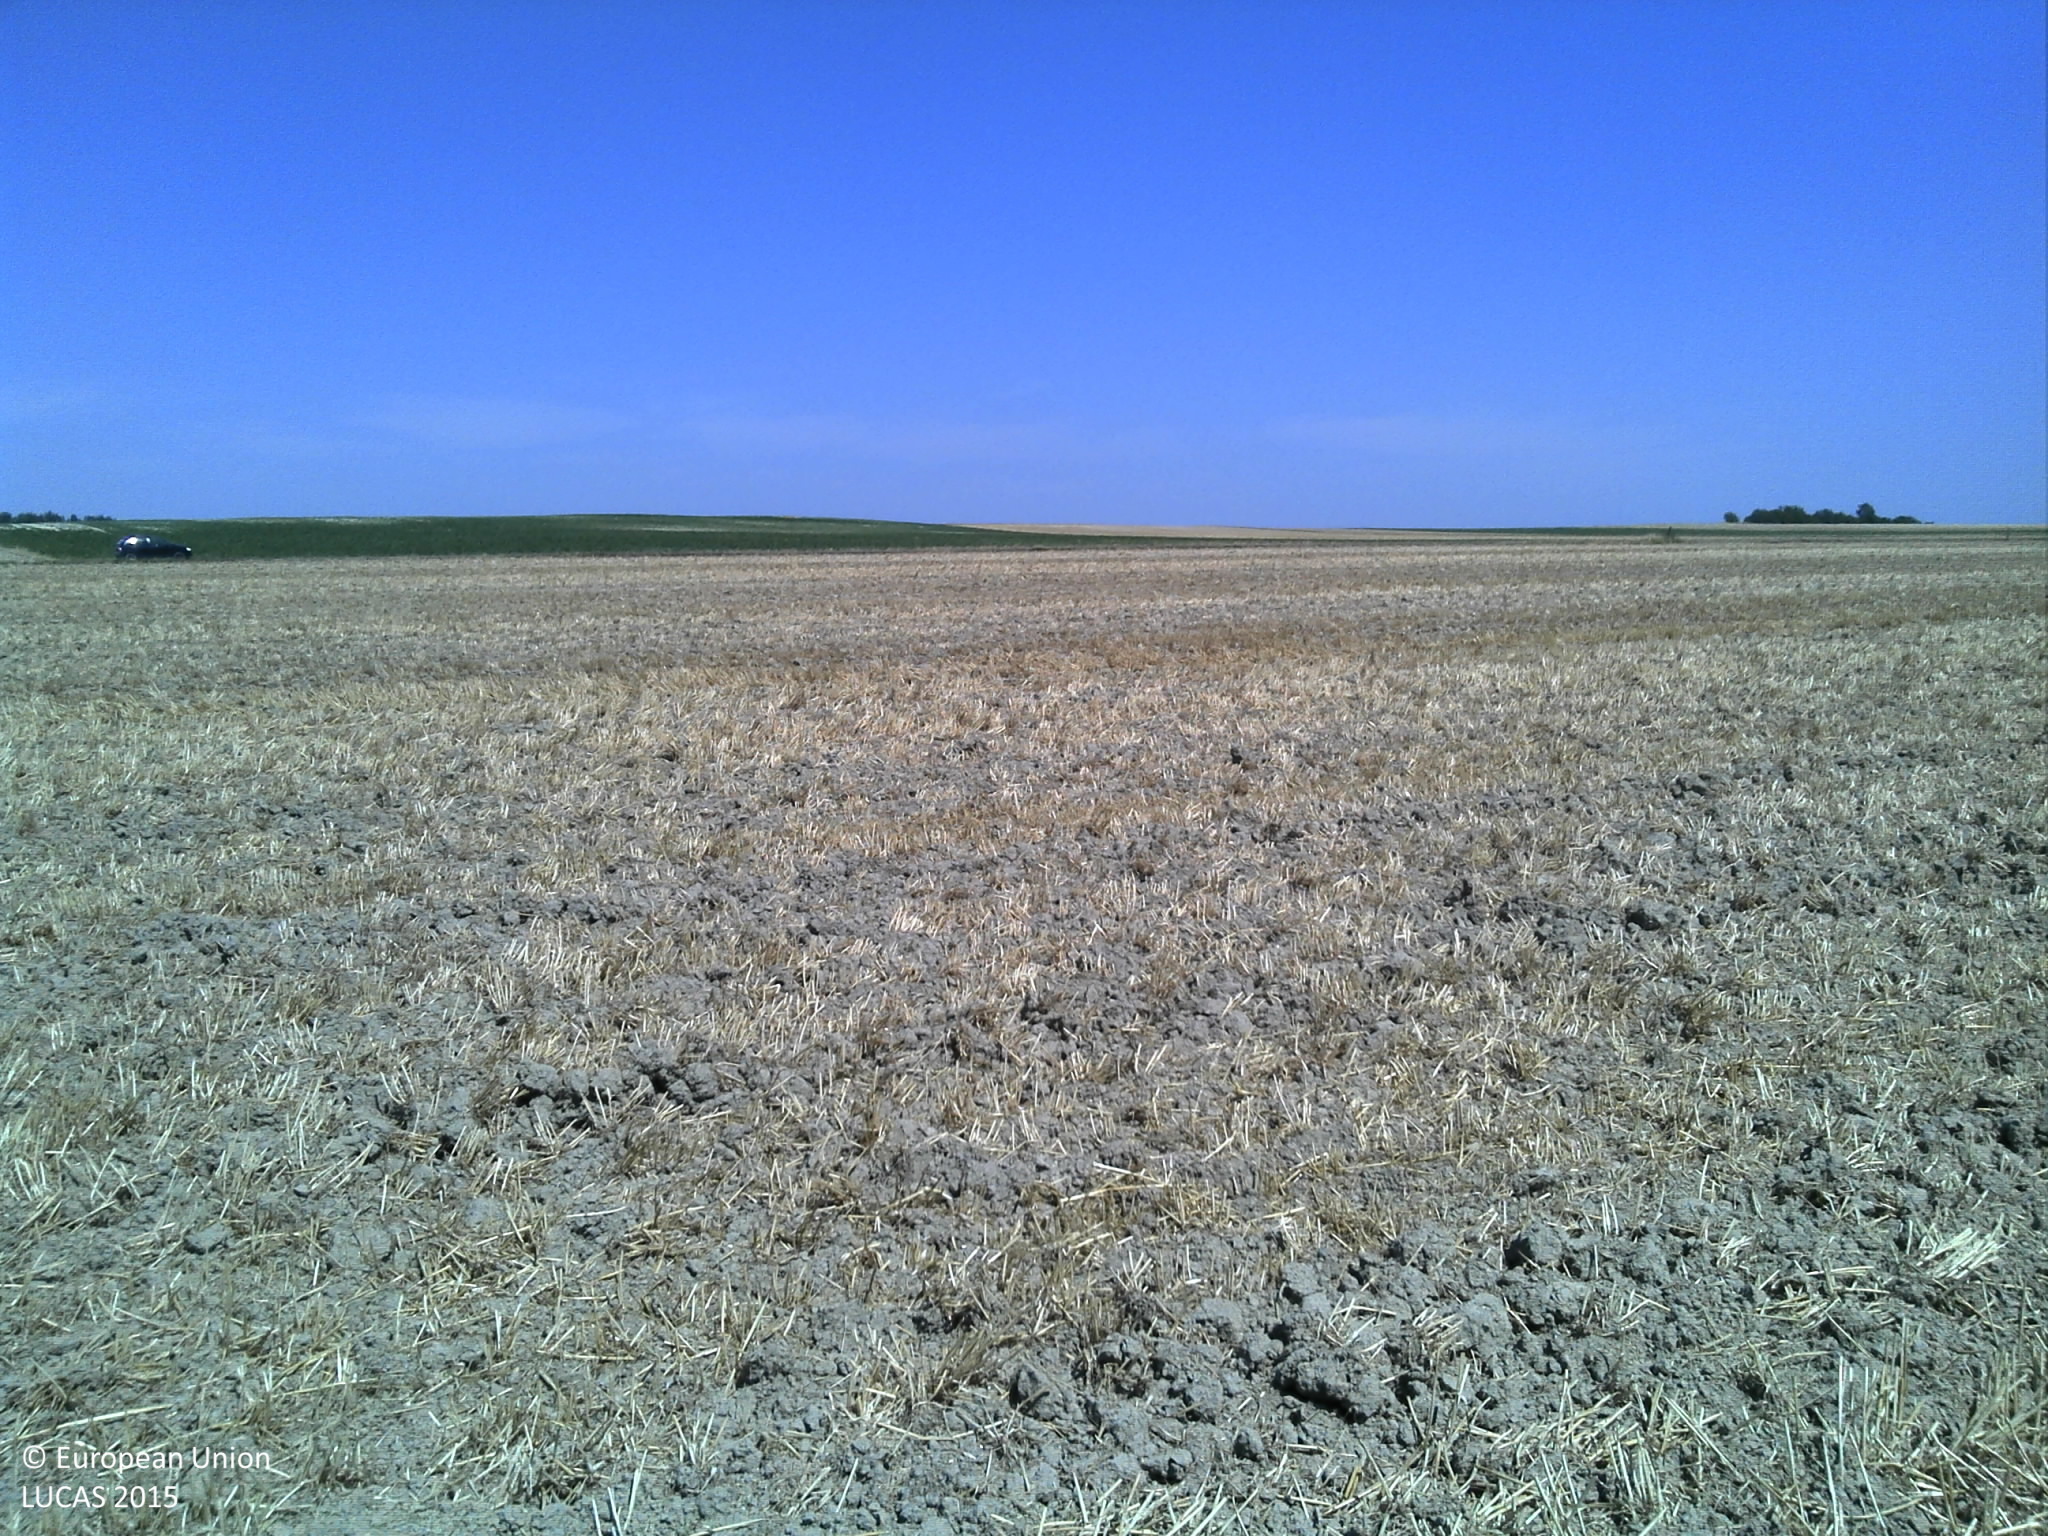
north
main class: Cropland
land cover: Common wheat
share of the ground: > 75 %
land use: Agriculture (excluding fallow land and kitchen gardens)
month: August
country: FR
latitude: 49.2350
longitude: 4.7646
